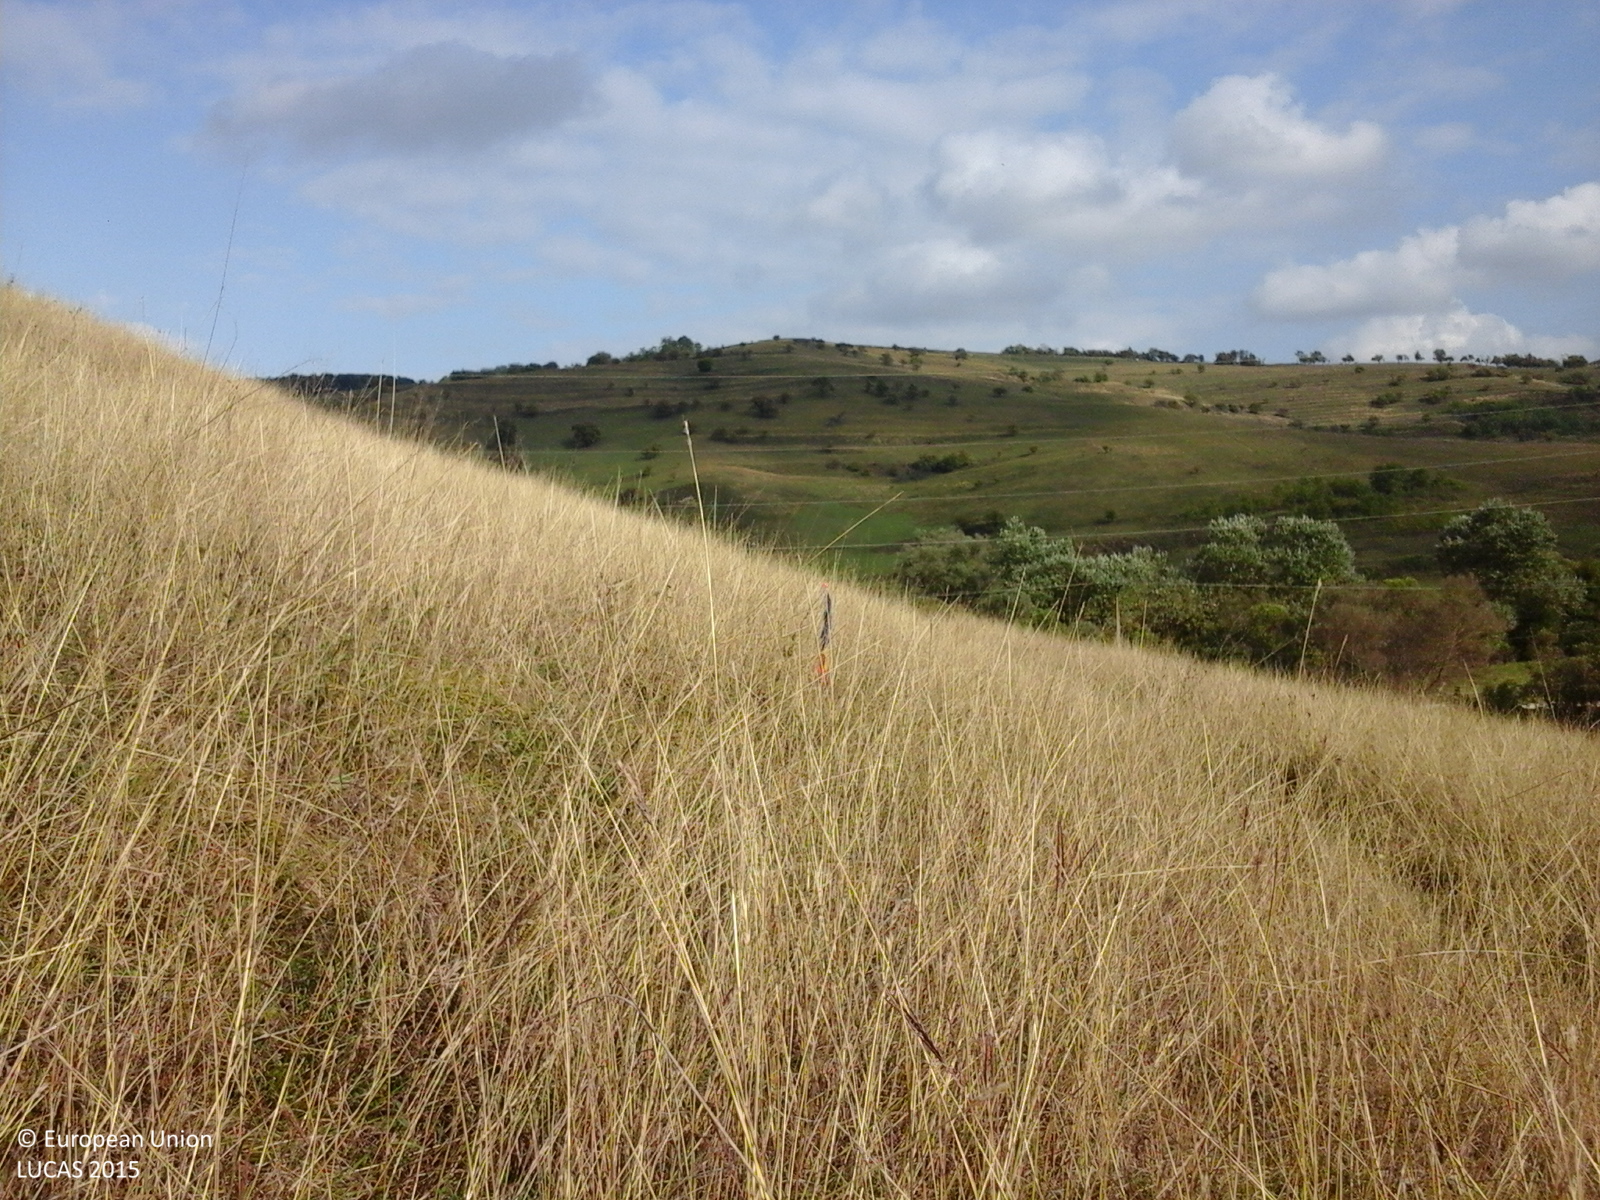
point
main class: Grassland
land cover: Grassland without tree/shrub cover
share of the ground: > 75 %
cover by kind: herbaceous plants 100 %
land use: Agriculture (excluding fallow land and kitchen gardens)
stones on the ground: < 10 %
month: October
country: RO
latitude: 46.1890
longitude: 24.1617
